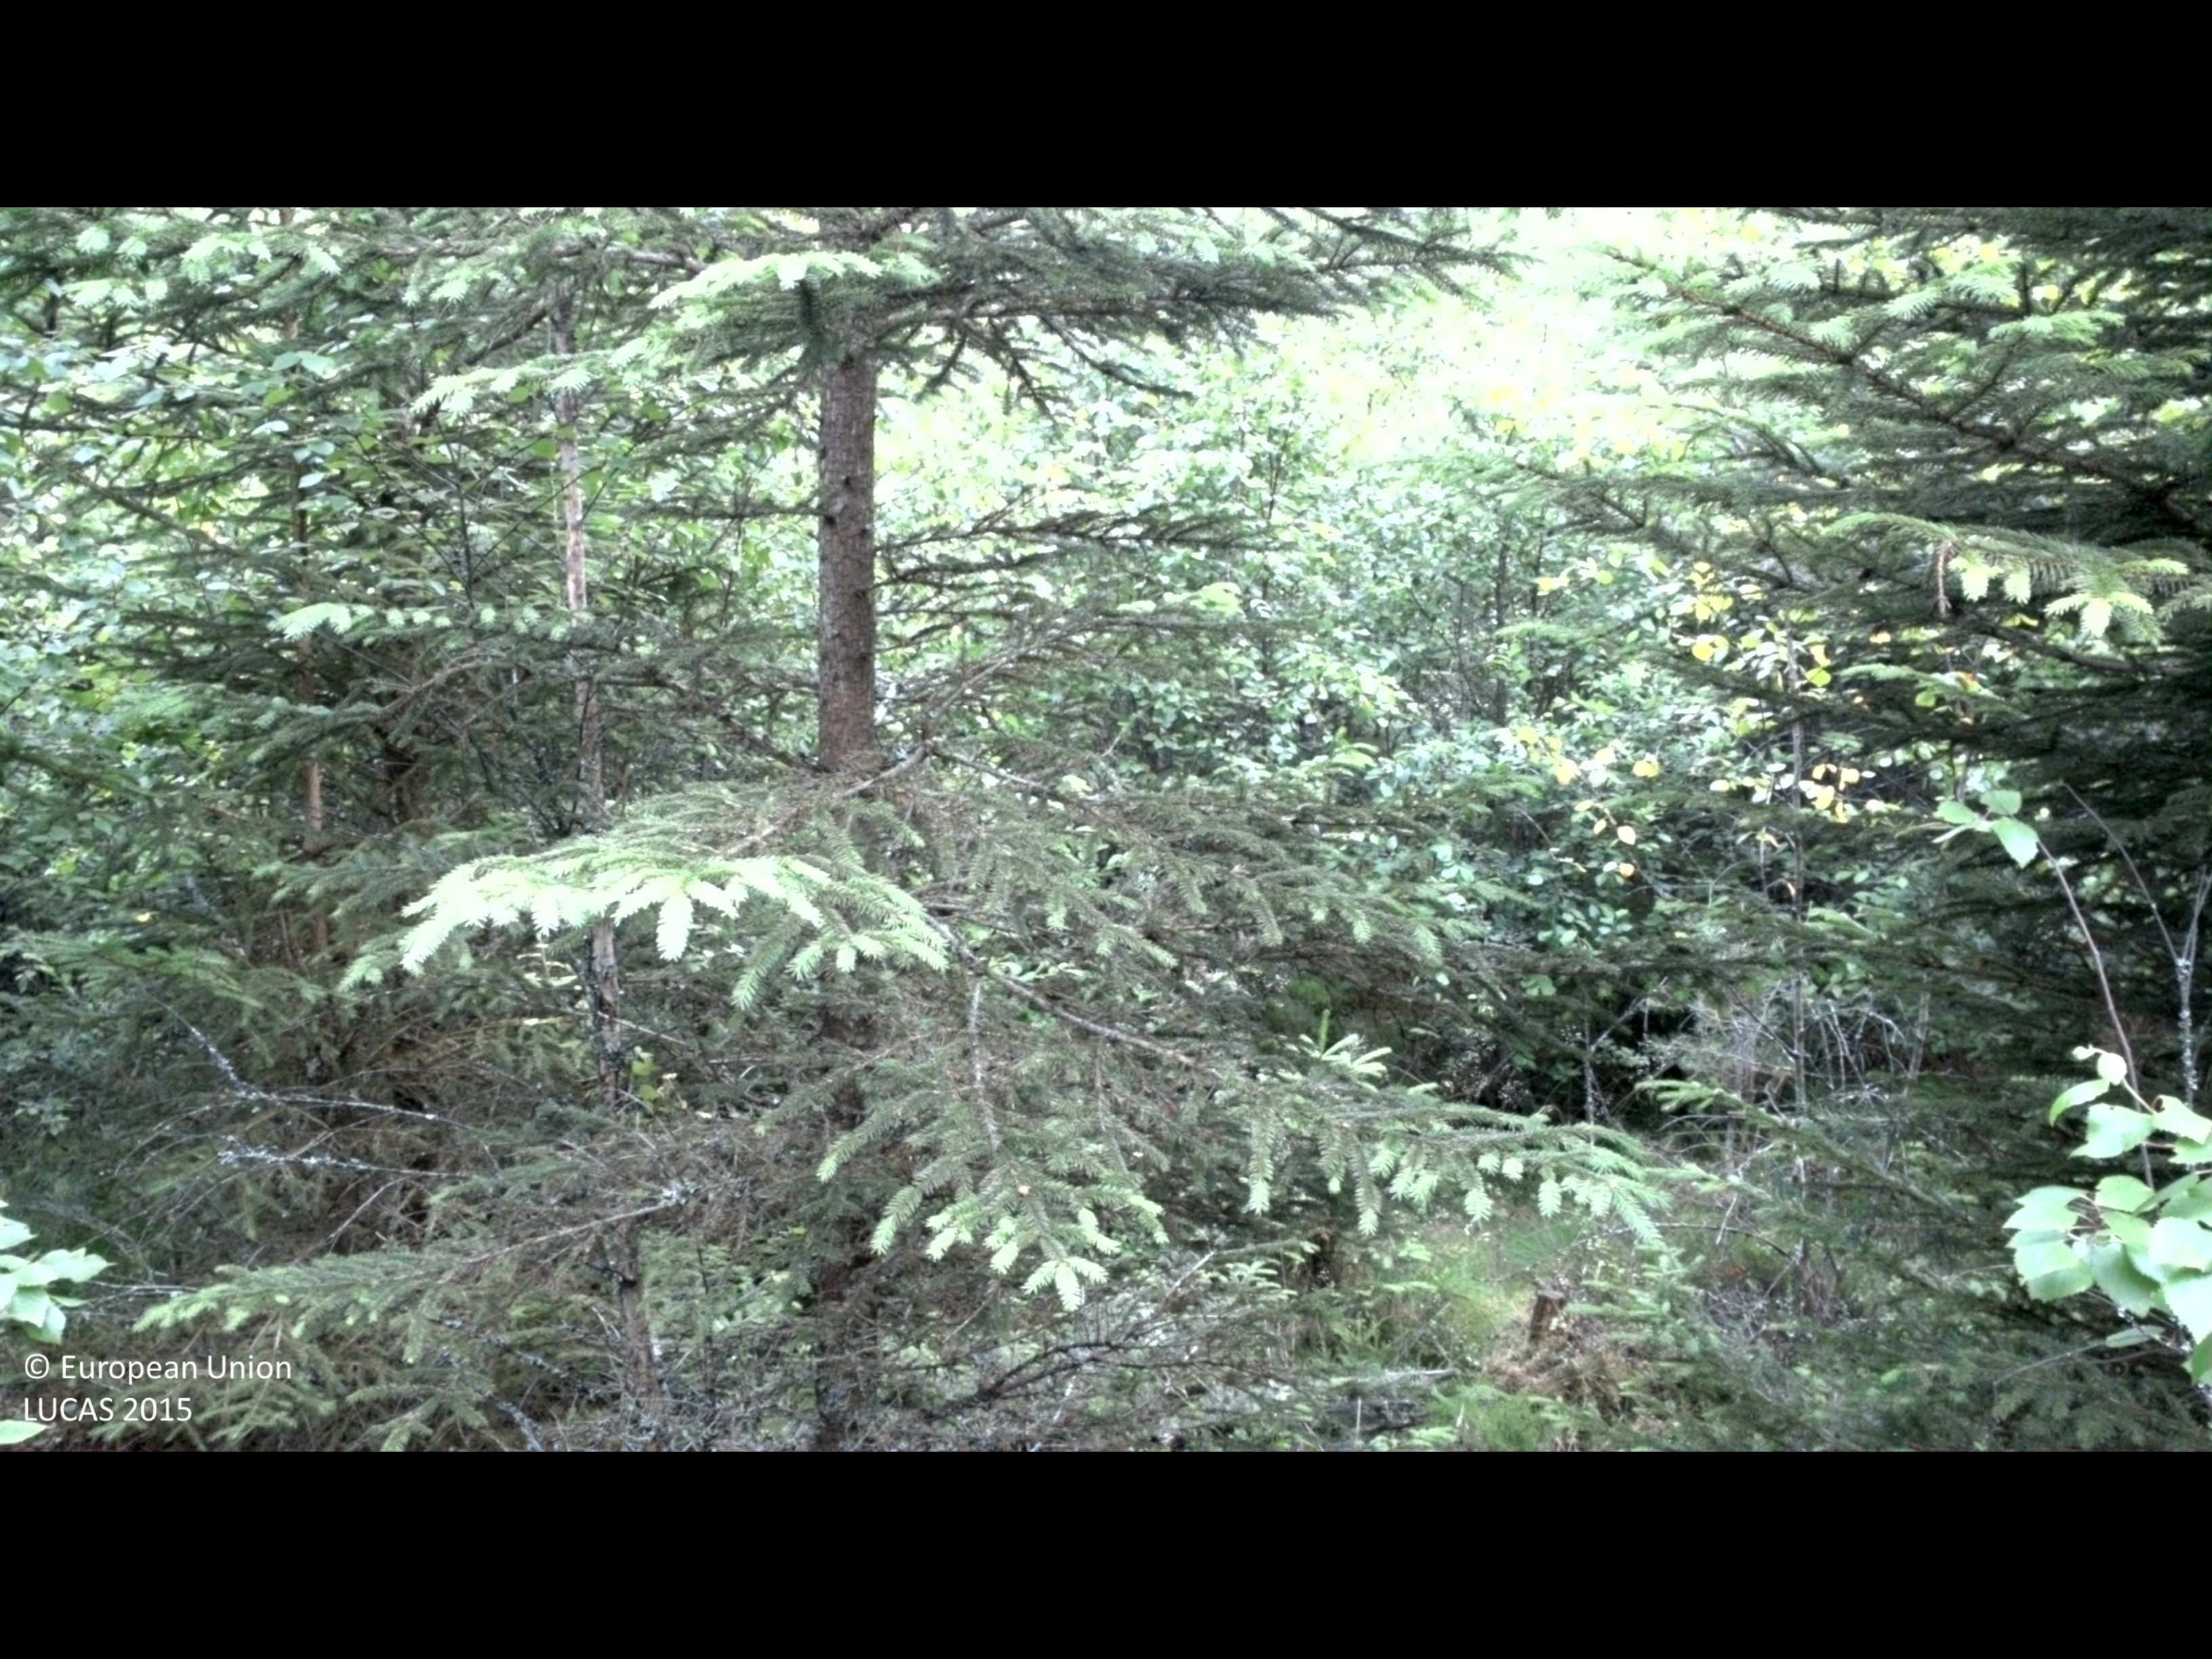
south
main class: Woodland
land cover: Spruce dominated mixed woodland
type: boreal forest
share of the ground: > 75 %
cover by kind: coniferous forest trees 45 %, broadleaved forest trees 35 %, shrubs 10 %, herbaceous plants 5 %, lichens and mosses 5 %
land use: Forestry
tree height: < 5 m
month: July
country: SE
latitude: 56.6509
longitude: 14.4499
